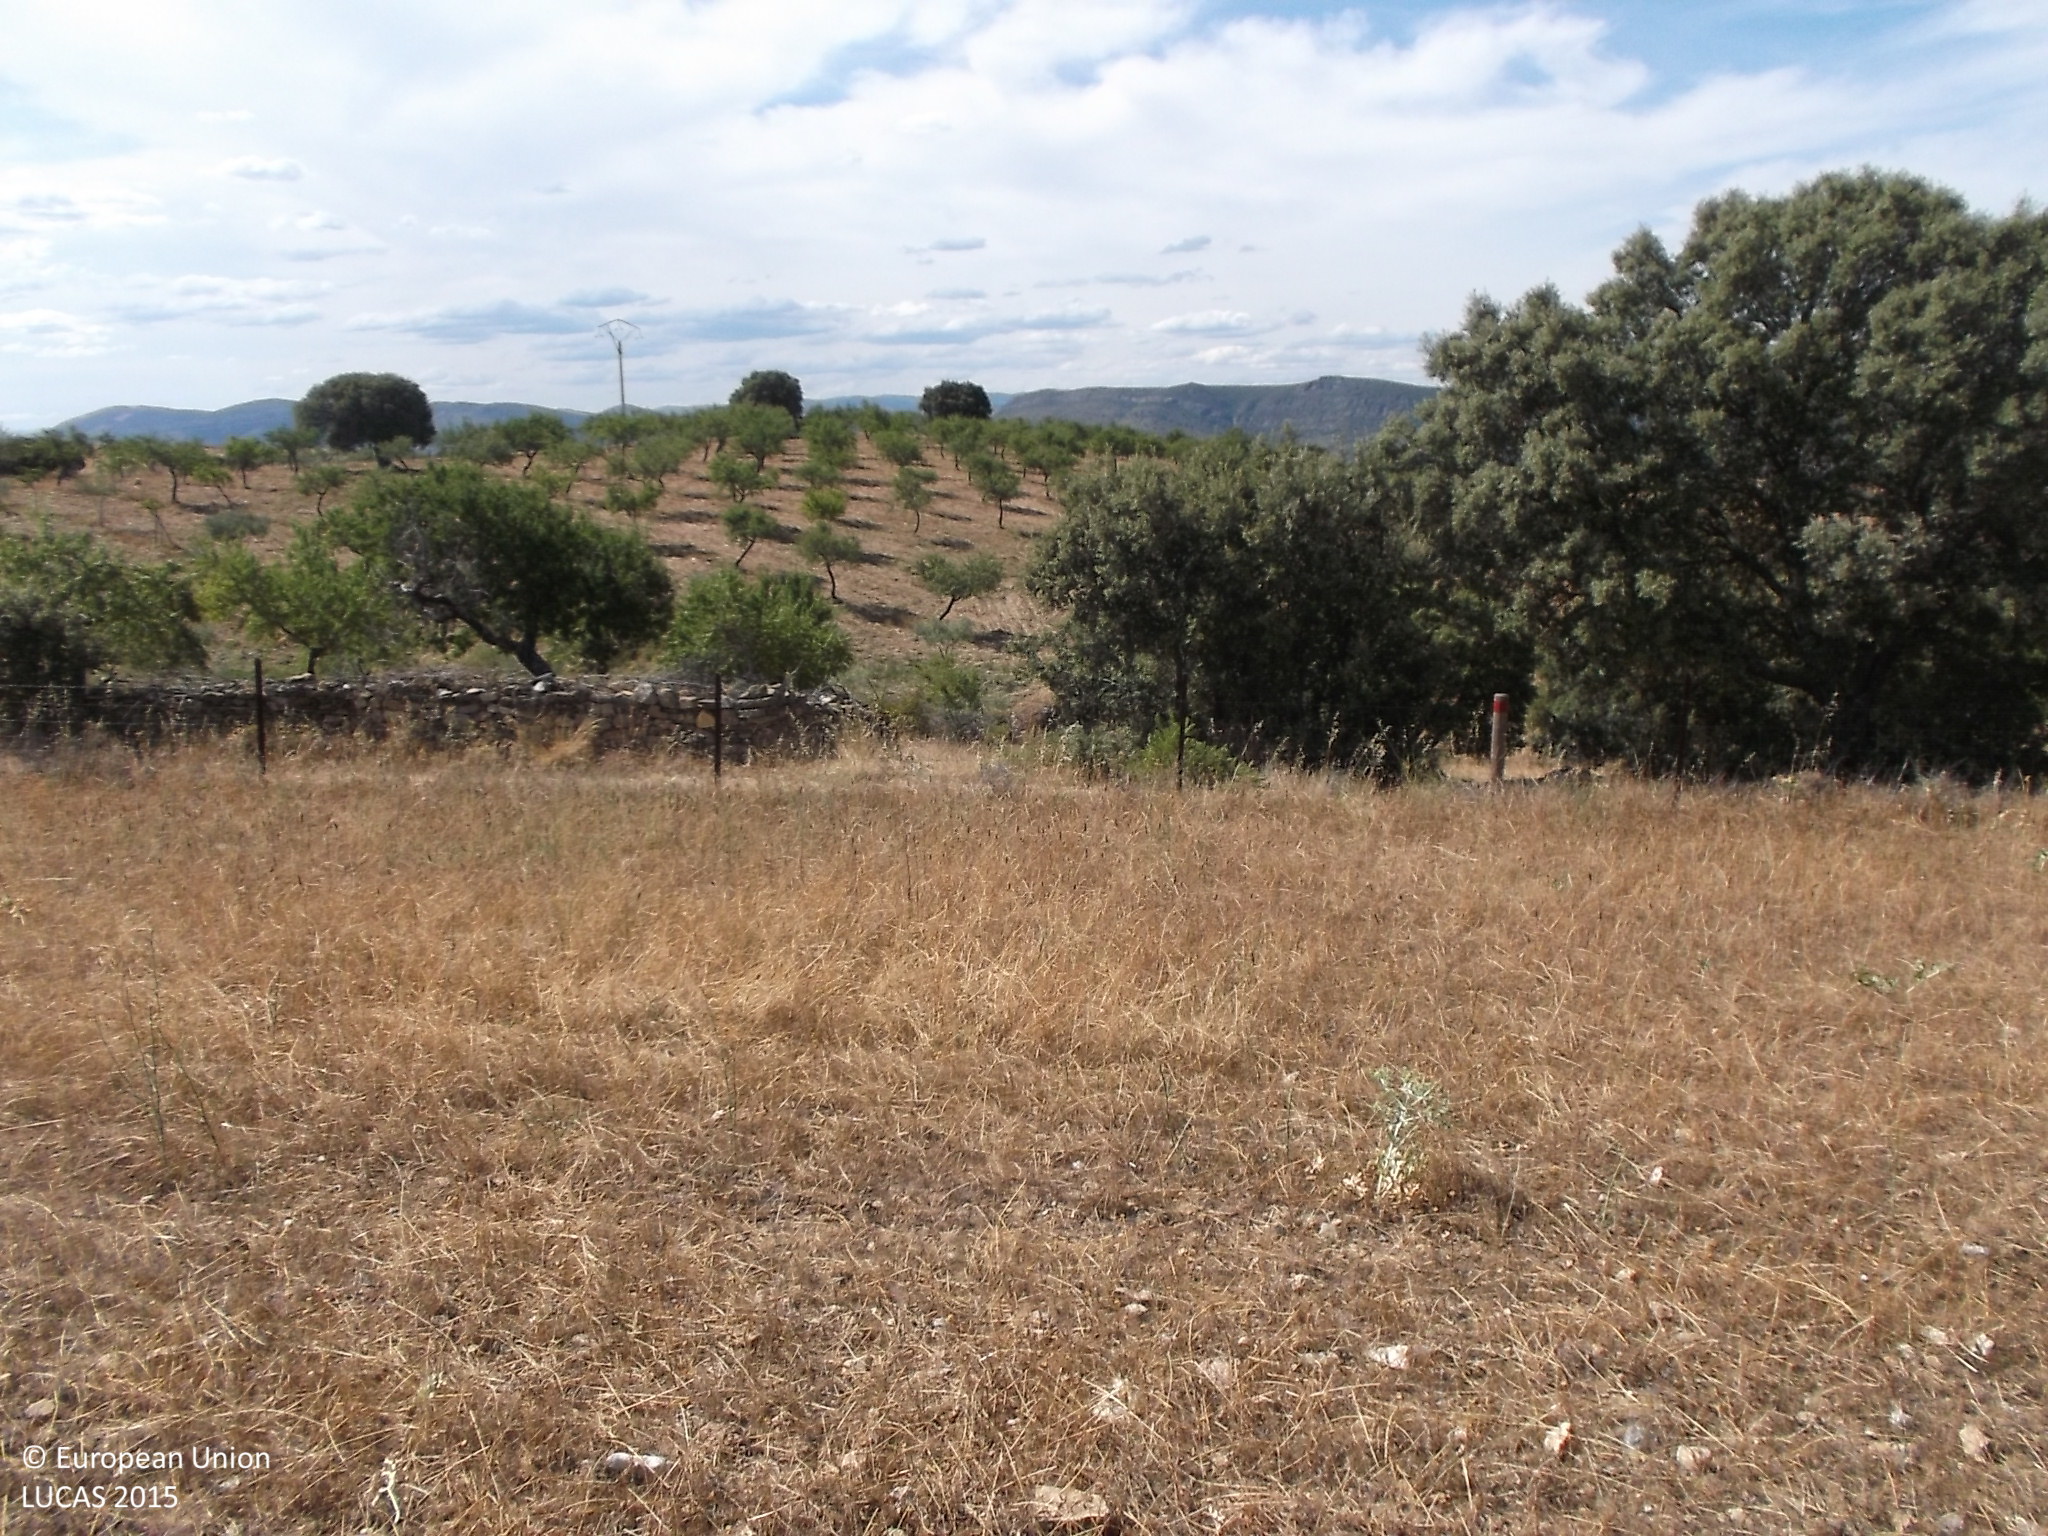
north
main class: Grassland
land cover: Grassland without tree/shrub cover
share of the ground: > 75 %
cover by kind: herbaceous plants 95 %, shrubs 5 %
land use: Agriculture (excluding fallow land and kitchen gardens)
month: July
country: ES
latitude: 40.9907
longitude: -6.8517
